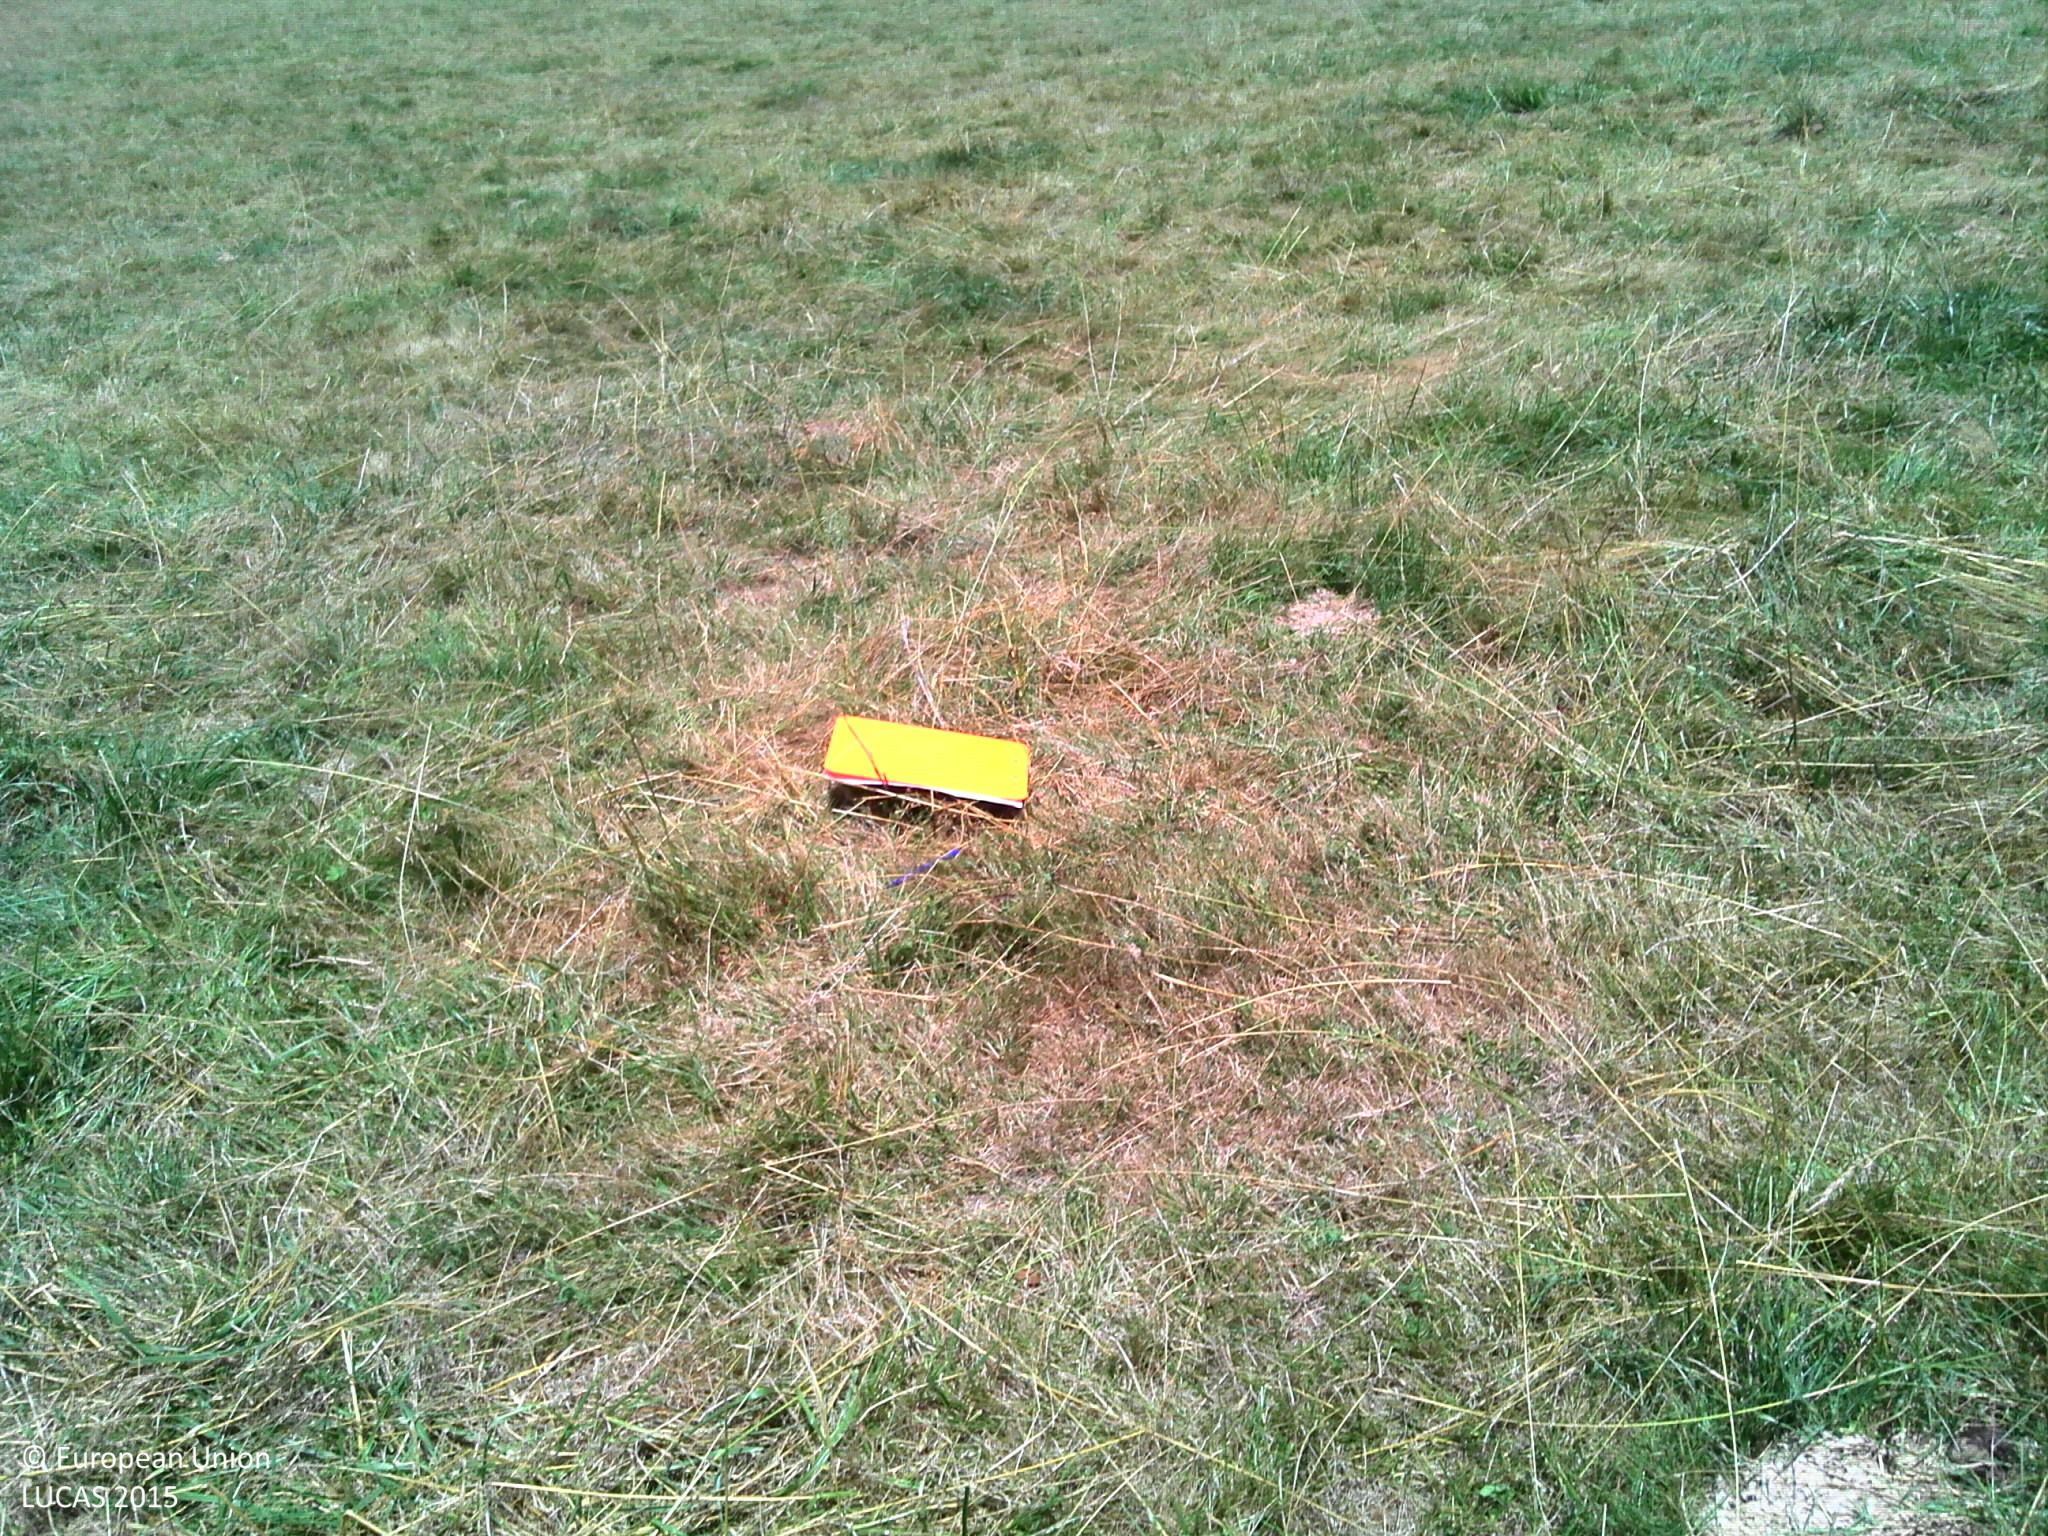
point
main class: Grassland
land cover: Grassland without tree/shrub cover
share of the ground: > 75 %
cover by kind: herbaceous plants 100 %
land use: Agriculture (excluding fallow land and kitchen gardens)
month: July
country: FR
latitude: 43.0860
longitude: 0.7771
